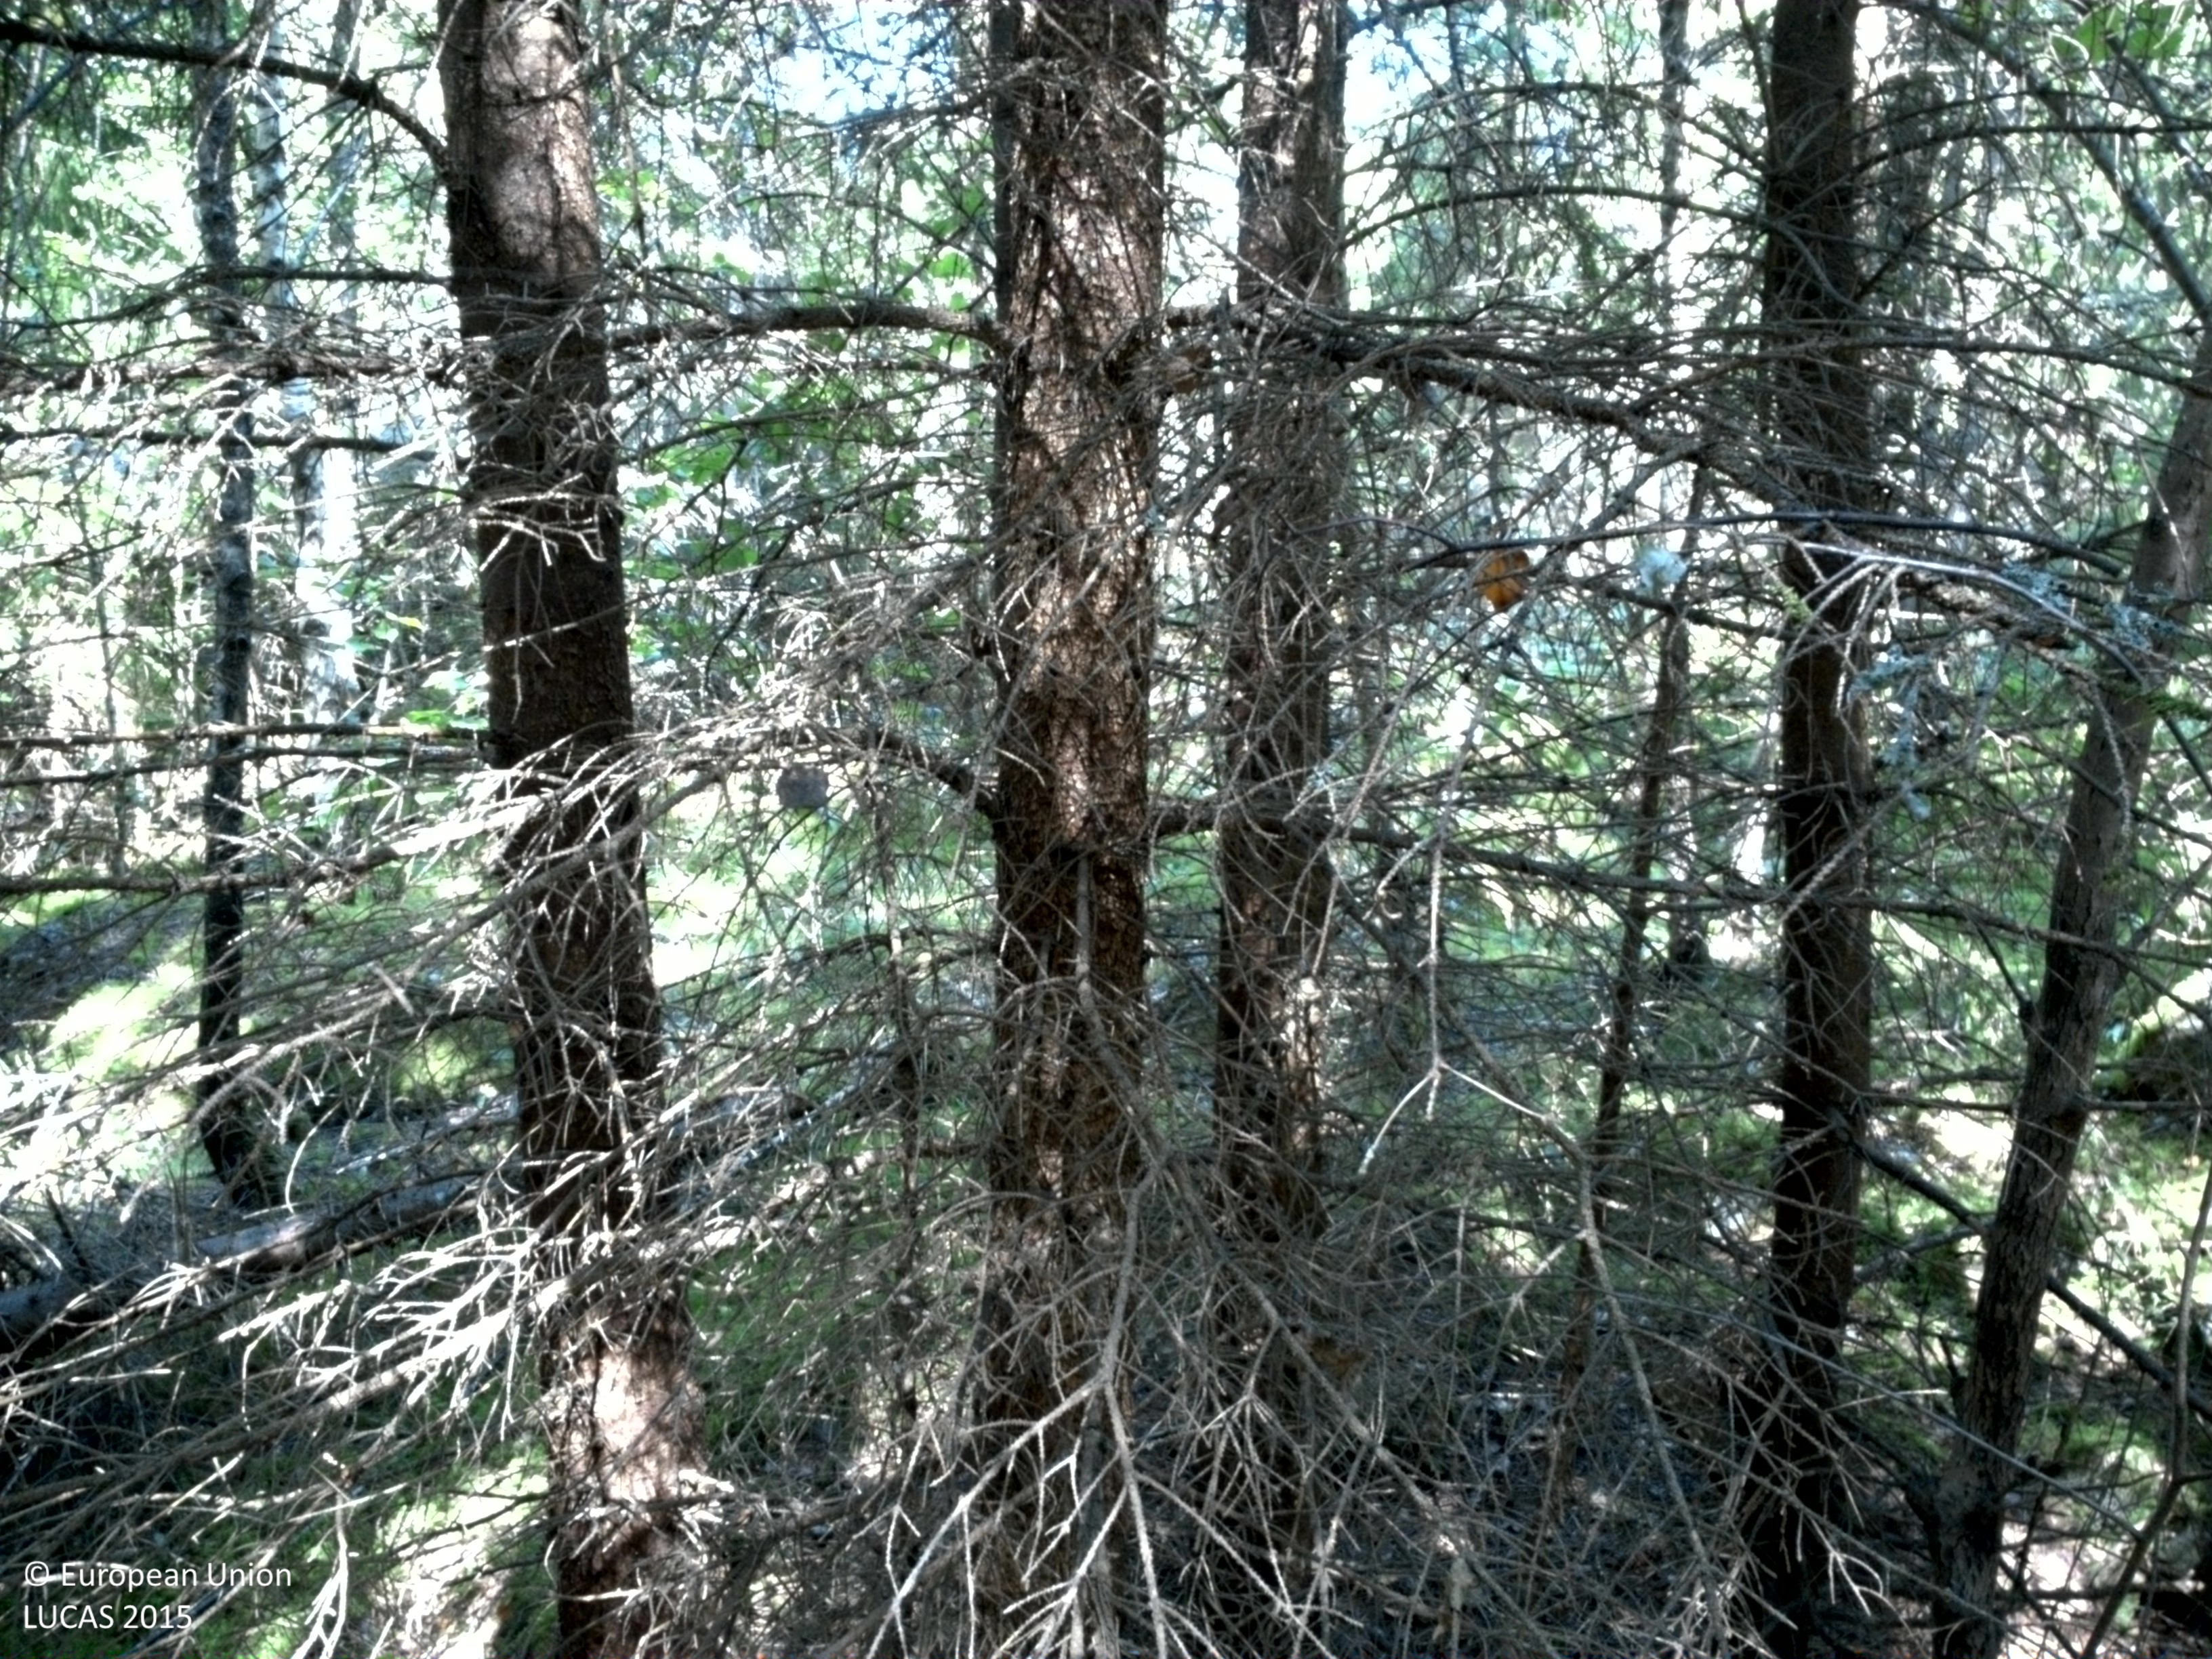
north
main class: Woodland
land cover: Spruce dominated coniferous woodland
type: boreal forest
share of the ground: > 75 %
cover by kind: coniferous forest trees 95 %, lichens and mosses 5 %
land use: Forestry
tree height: > 5 m
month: August
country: SE
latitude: 59.7013
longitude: 17.6541
